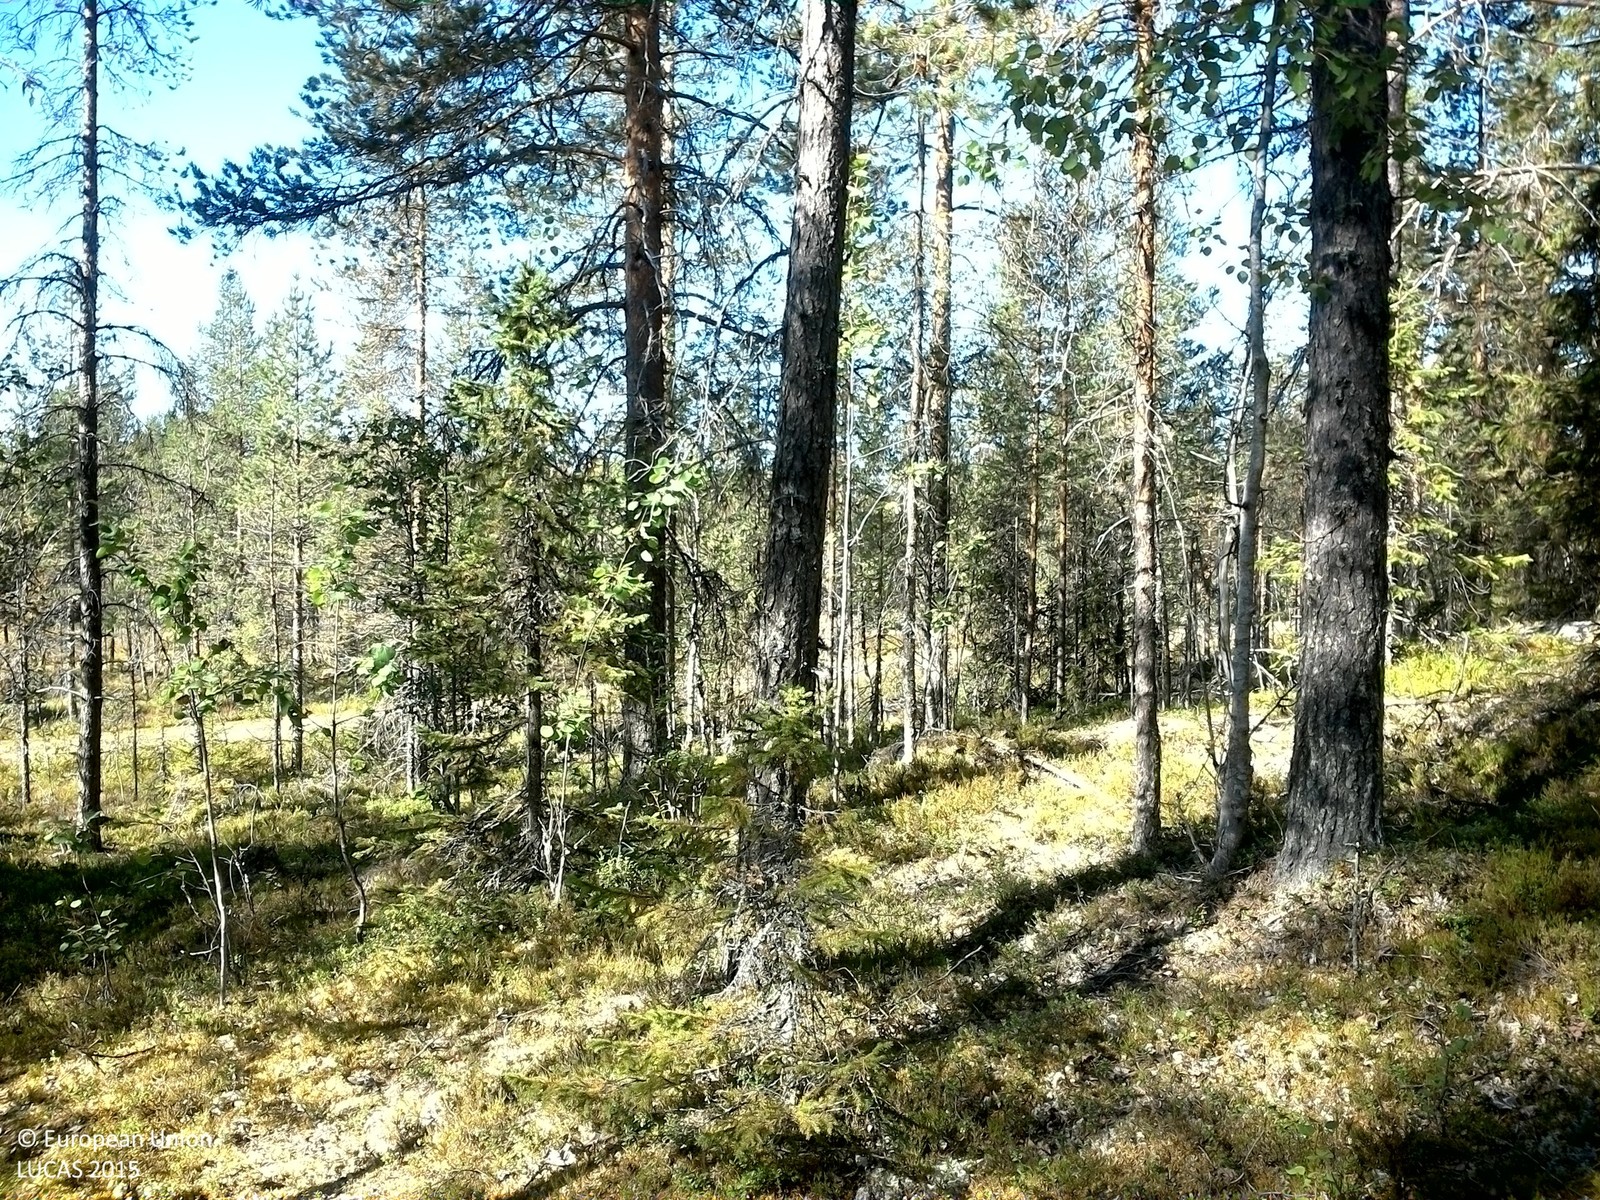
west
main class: Woodland
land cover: Pine dominated coniferous woodland
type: boreal forest
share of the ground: 50 - 75 %
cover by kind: coniferous forest trees 60 %, shrubs 30 %, lichens and mosses 10 %
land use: Forestry
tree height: > 5 m
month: August
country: SE
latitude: 63.6840
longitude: 17.7165
